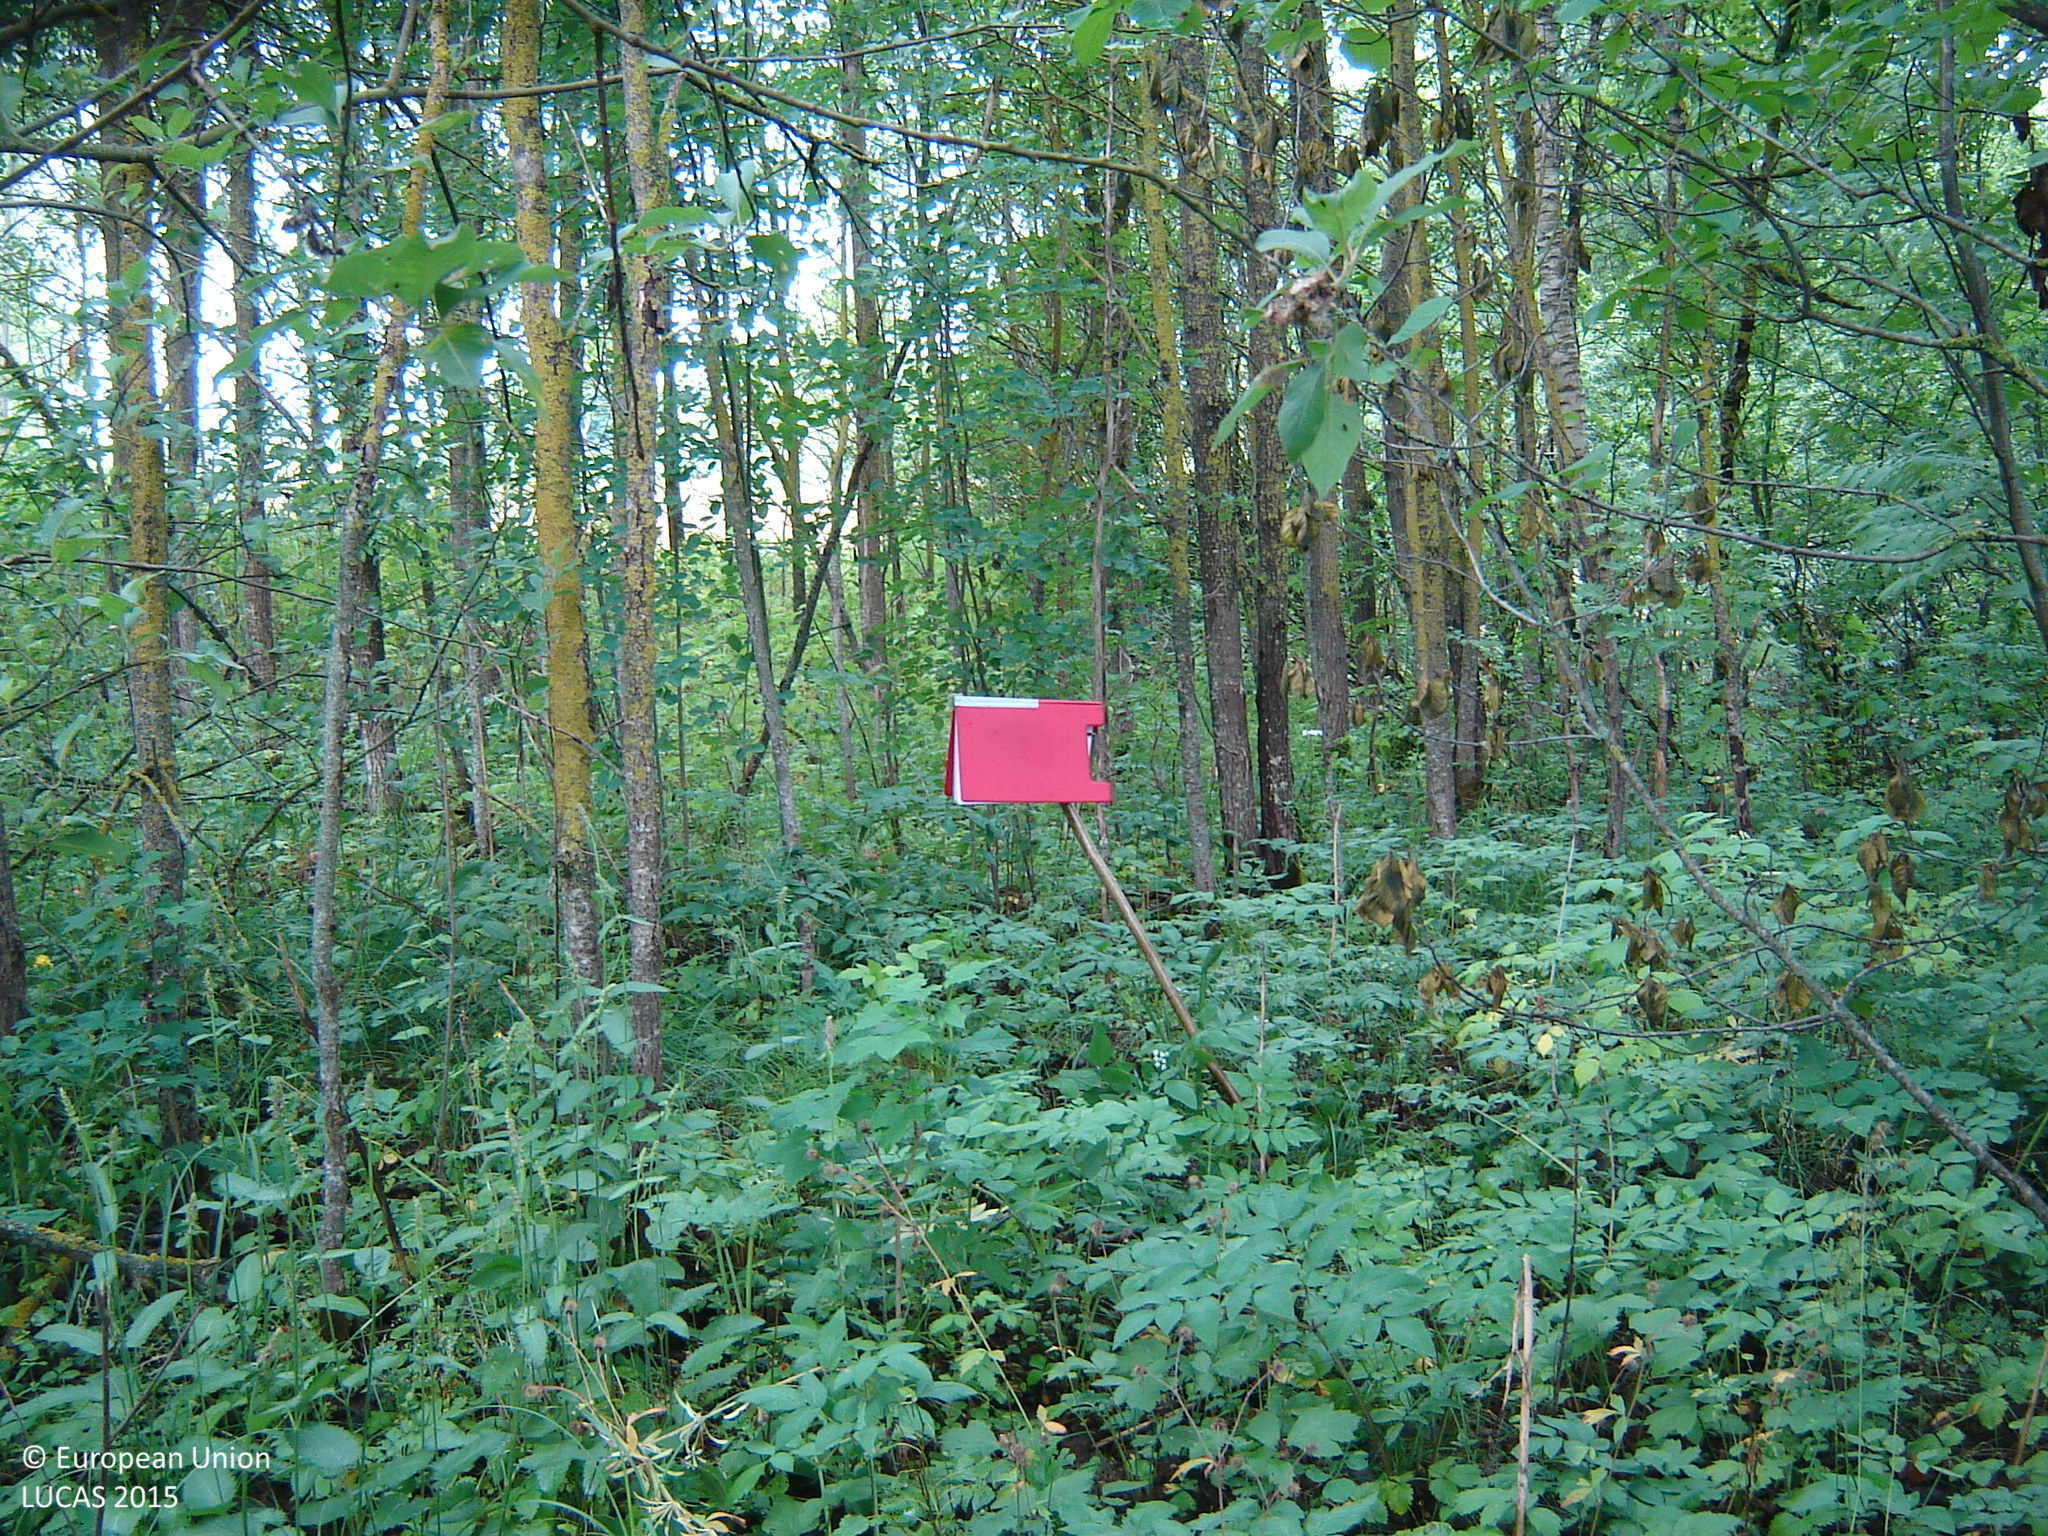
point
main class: Woodland
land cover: Broadleaved woodland
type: non-riverine alder, birch or aspen forest
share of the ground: > 75 %
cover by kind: broadleaved forest trees 90 %, herbaceous plants 10 %
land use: Forestry
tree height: > 5 m
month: July
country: LT
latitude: 55.3330
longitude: 25.1712
